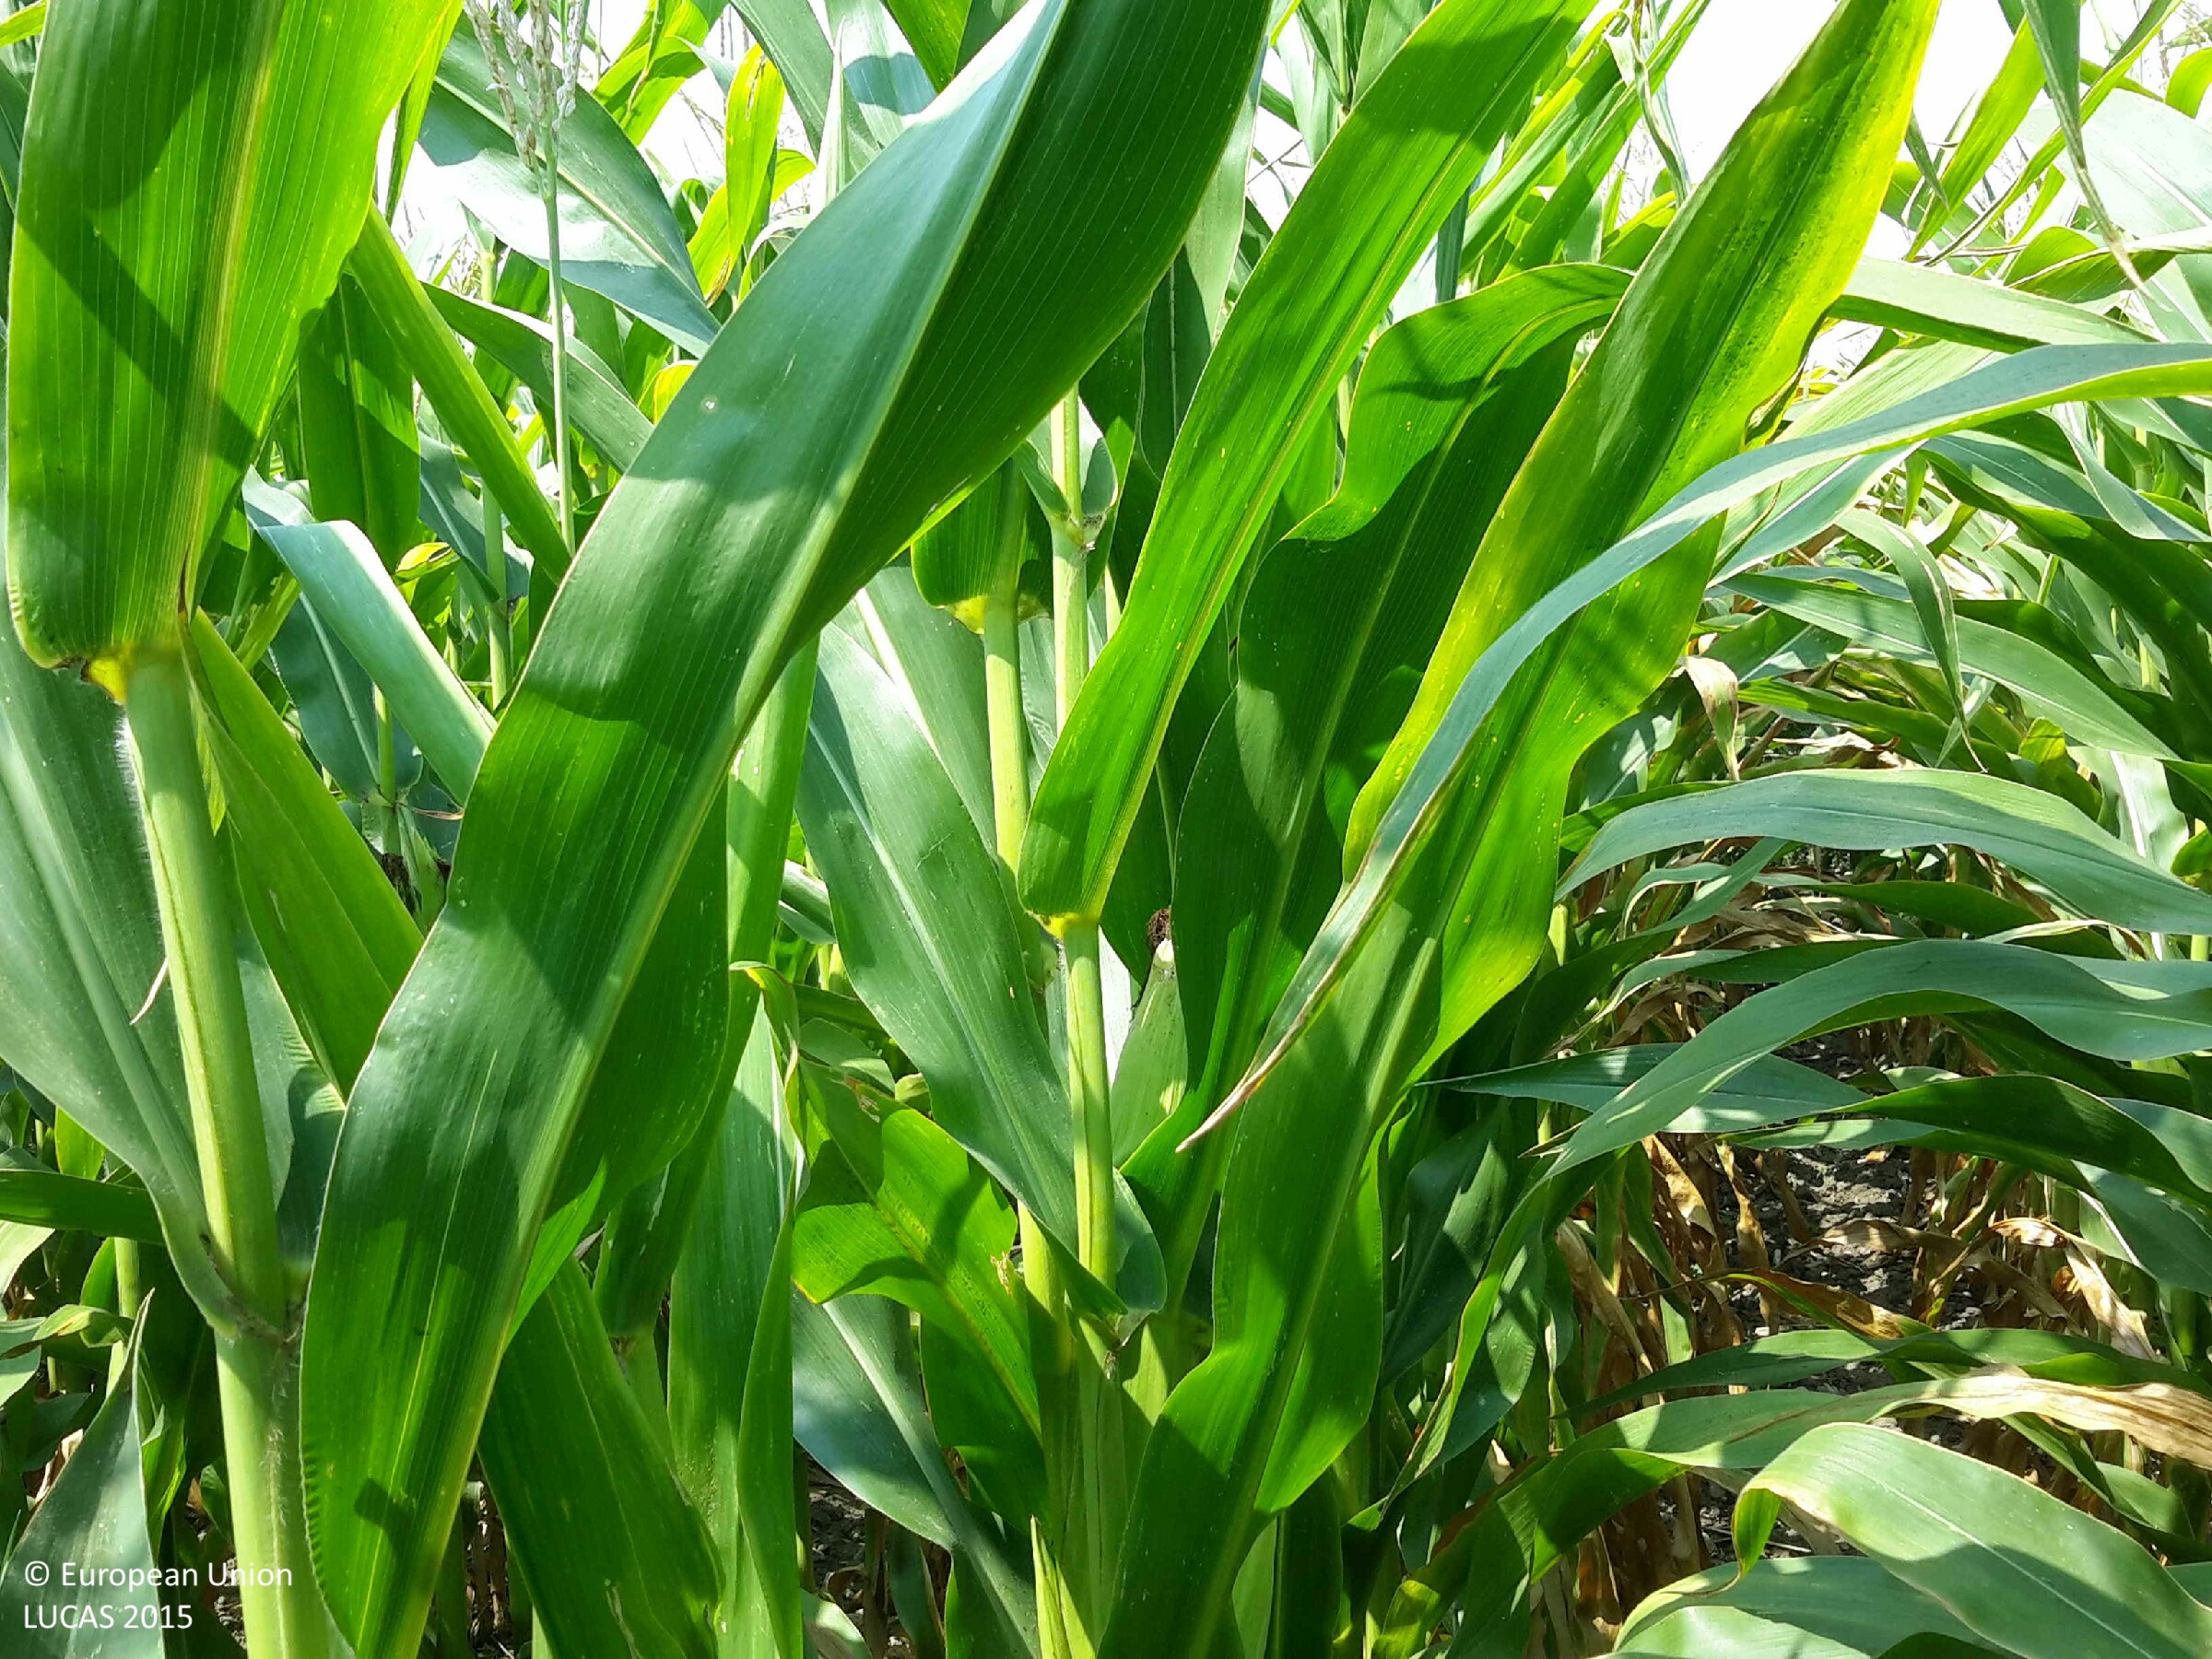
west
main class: Cropland
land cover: Maize
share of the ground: > 75 %
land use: Agriculture (excluding fallow land and kitchen gardens)
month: August
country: HU
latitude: 47.8304
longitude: 17.3960
